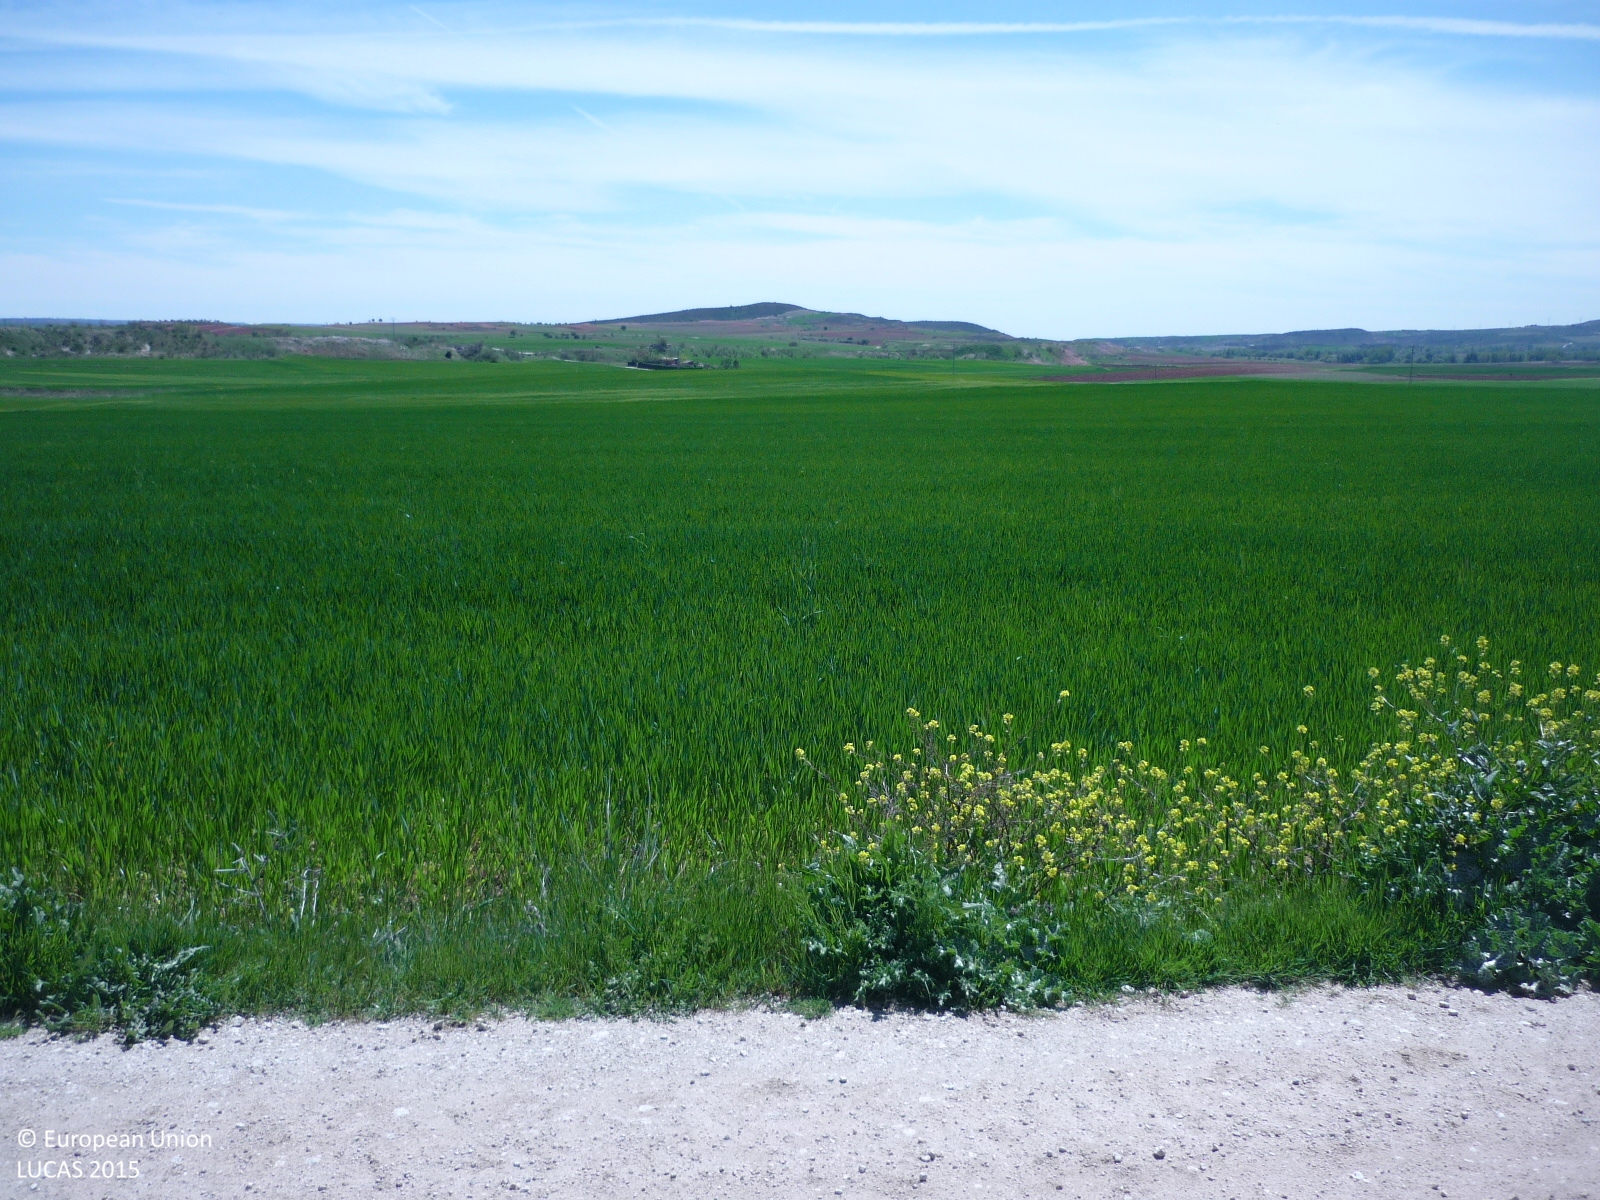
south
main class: Cropland
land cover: Barley
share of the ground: > 75 %
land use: Agriculture (excluding fallow land and kitchen gardens)
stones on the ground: 10 - 25 %
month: April
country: ES
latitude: 40.8278
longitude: -3.5225
